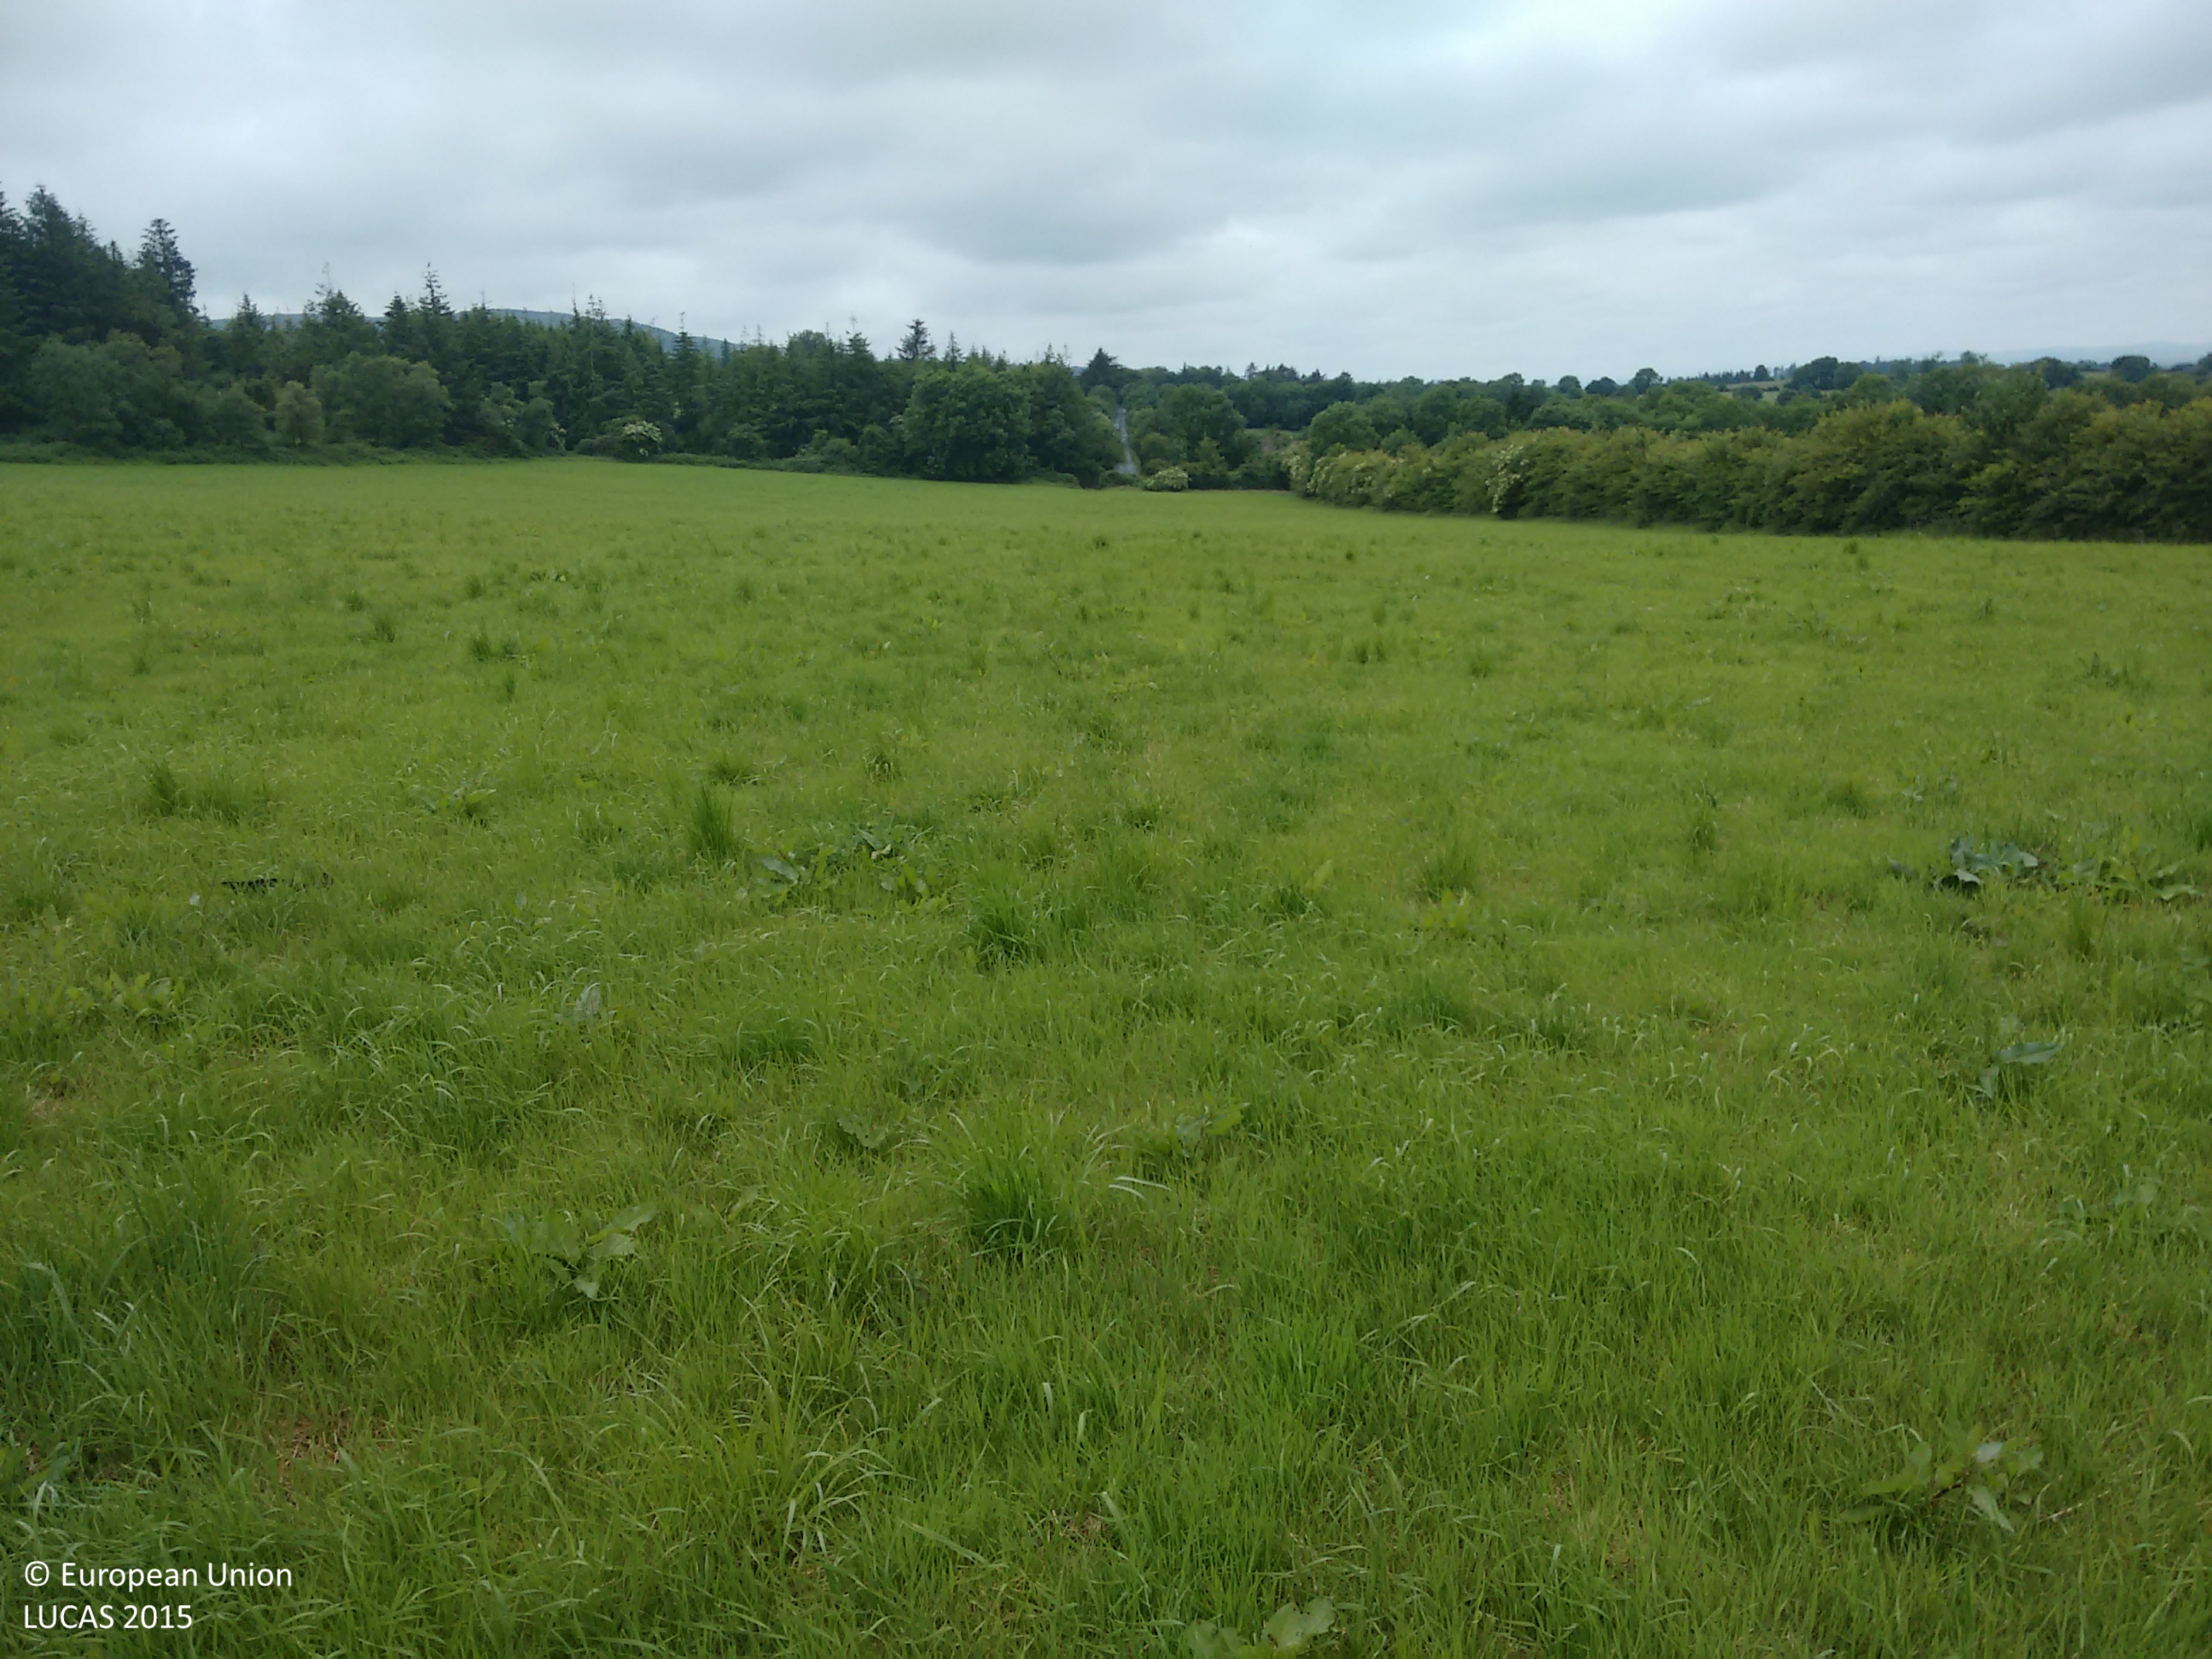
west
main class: Grassland
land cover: Grassland without tree/shrub cover
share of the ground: > 75 %
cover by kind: herbaceous plants 100 %
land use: Agriculture (excluding fallow land and kitchen gardens)
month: July
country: IE
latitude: 52.3328
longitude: -8.4632
